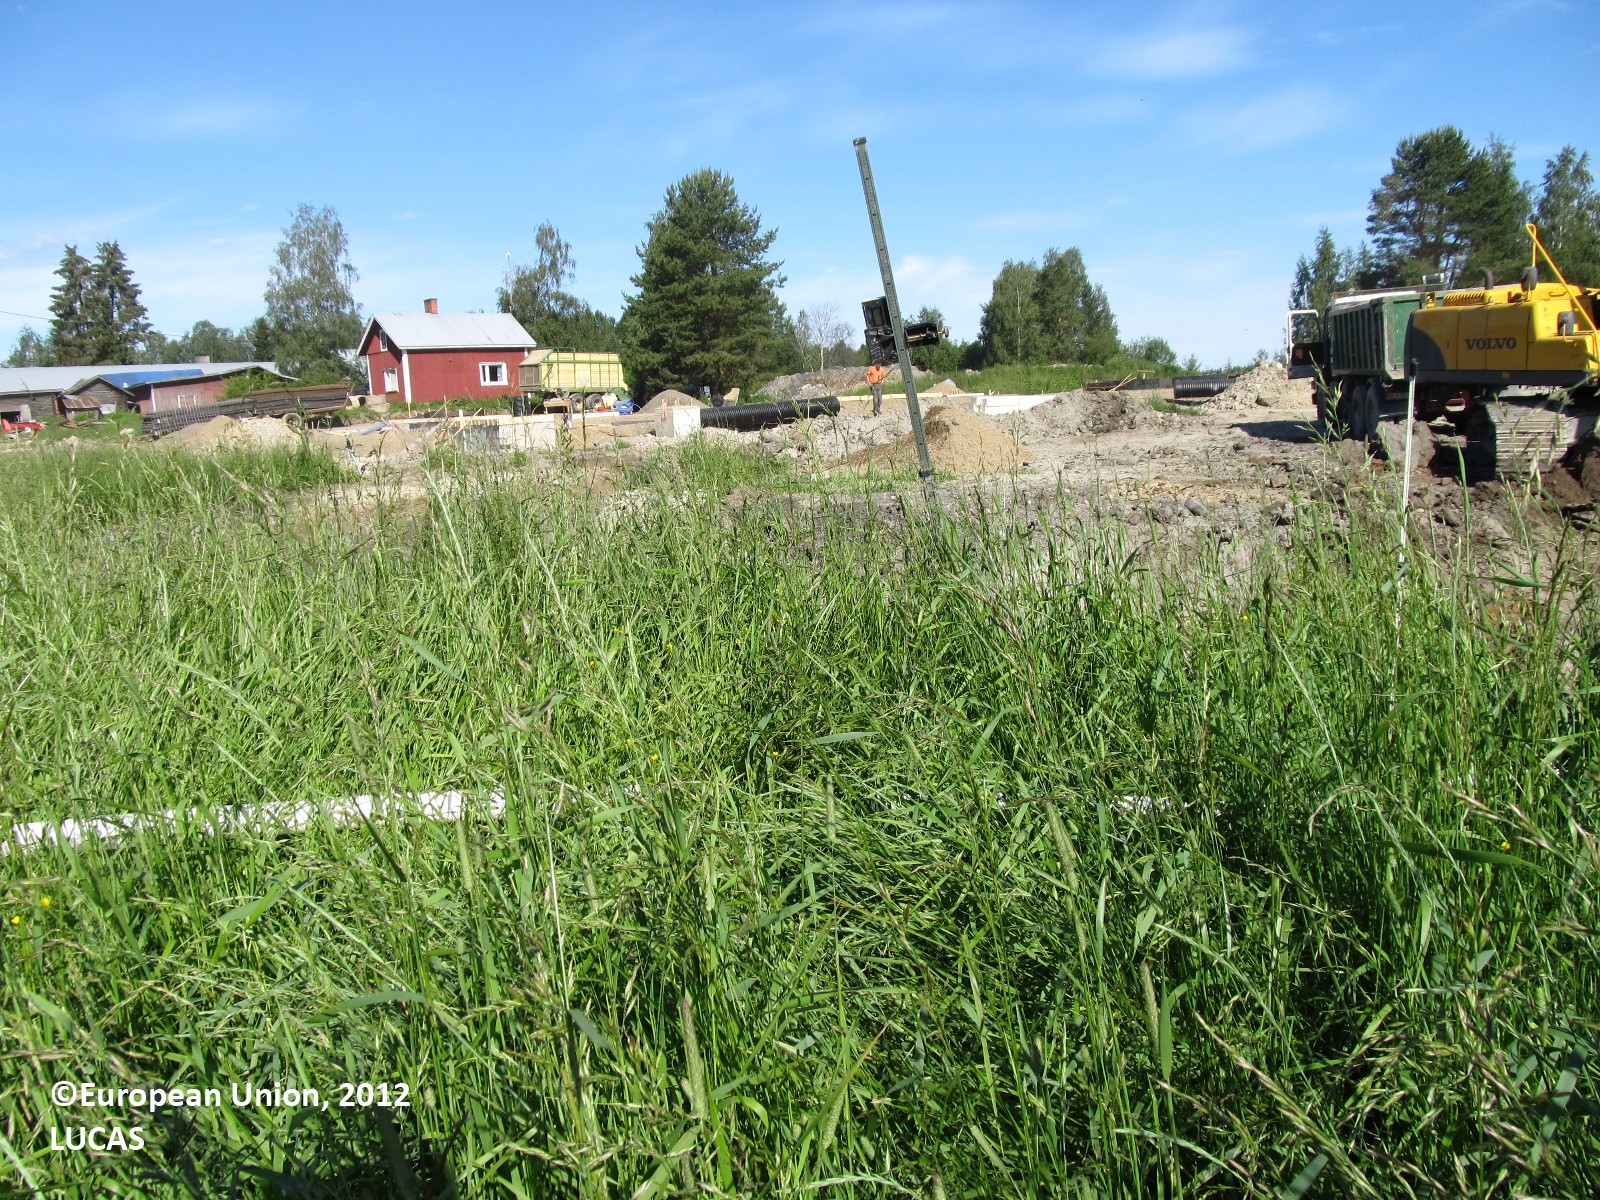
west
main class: Grassland
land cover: Grassland without tree/shrub cover
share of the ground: > 75 %
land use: Agriculture (excluding fallow land and kitchen gardens)
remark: Harvested field
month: July
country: FI
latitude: 62.6320
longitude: 29.1576
